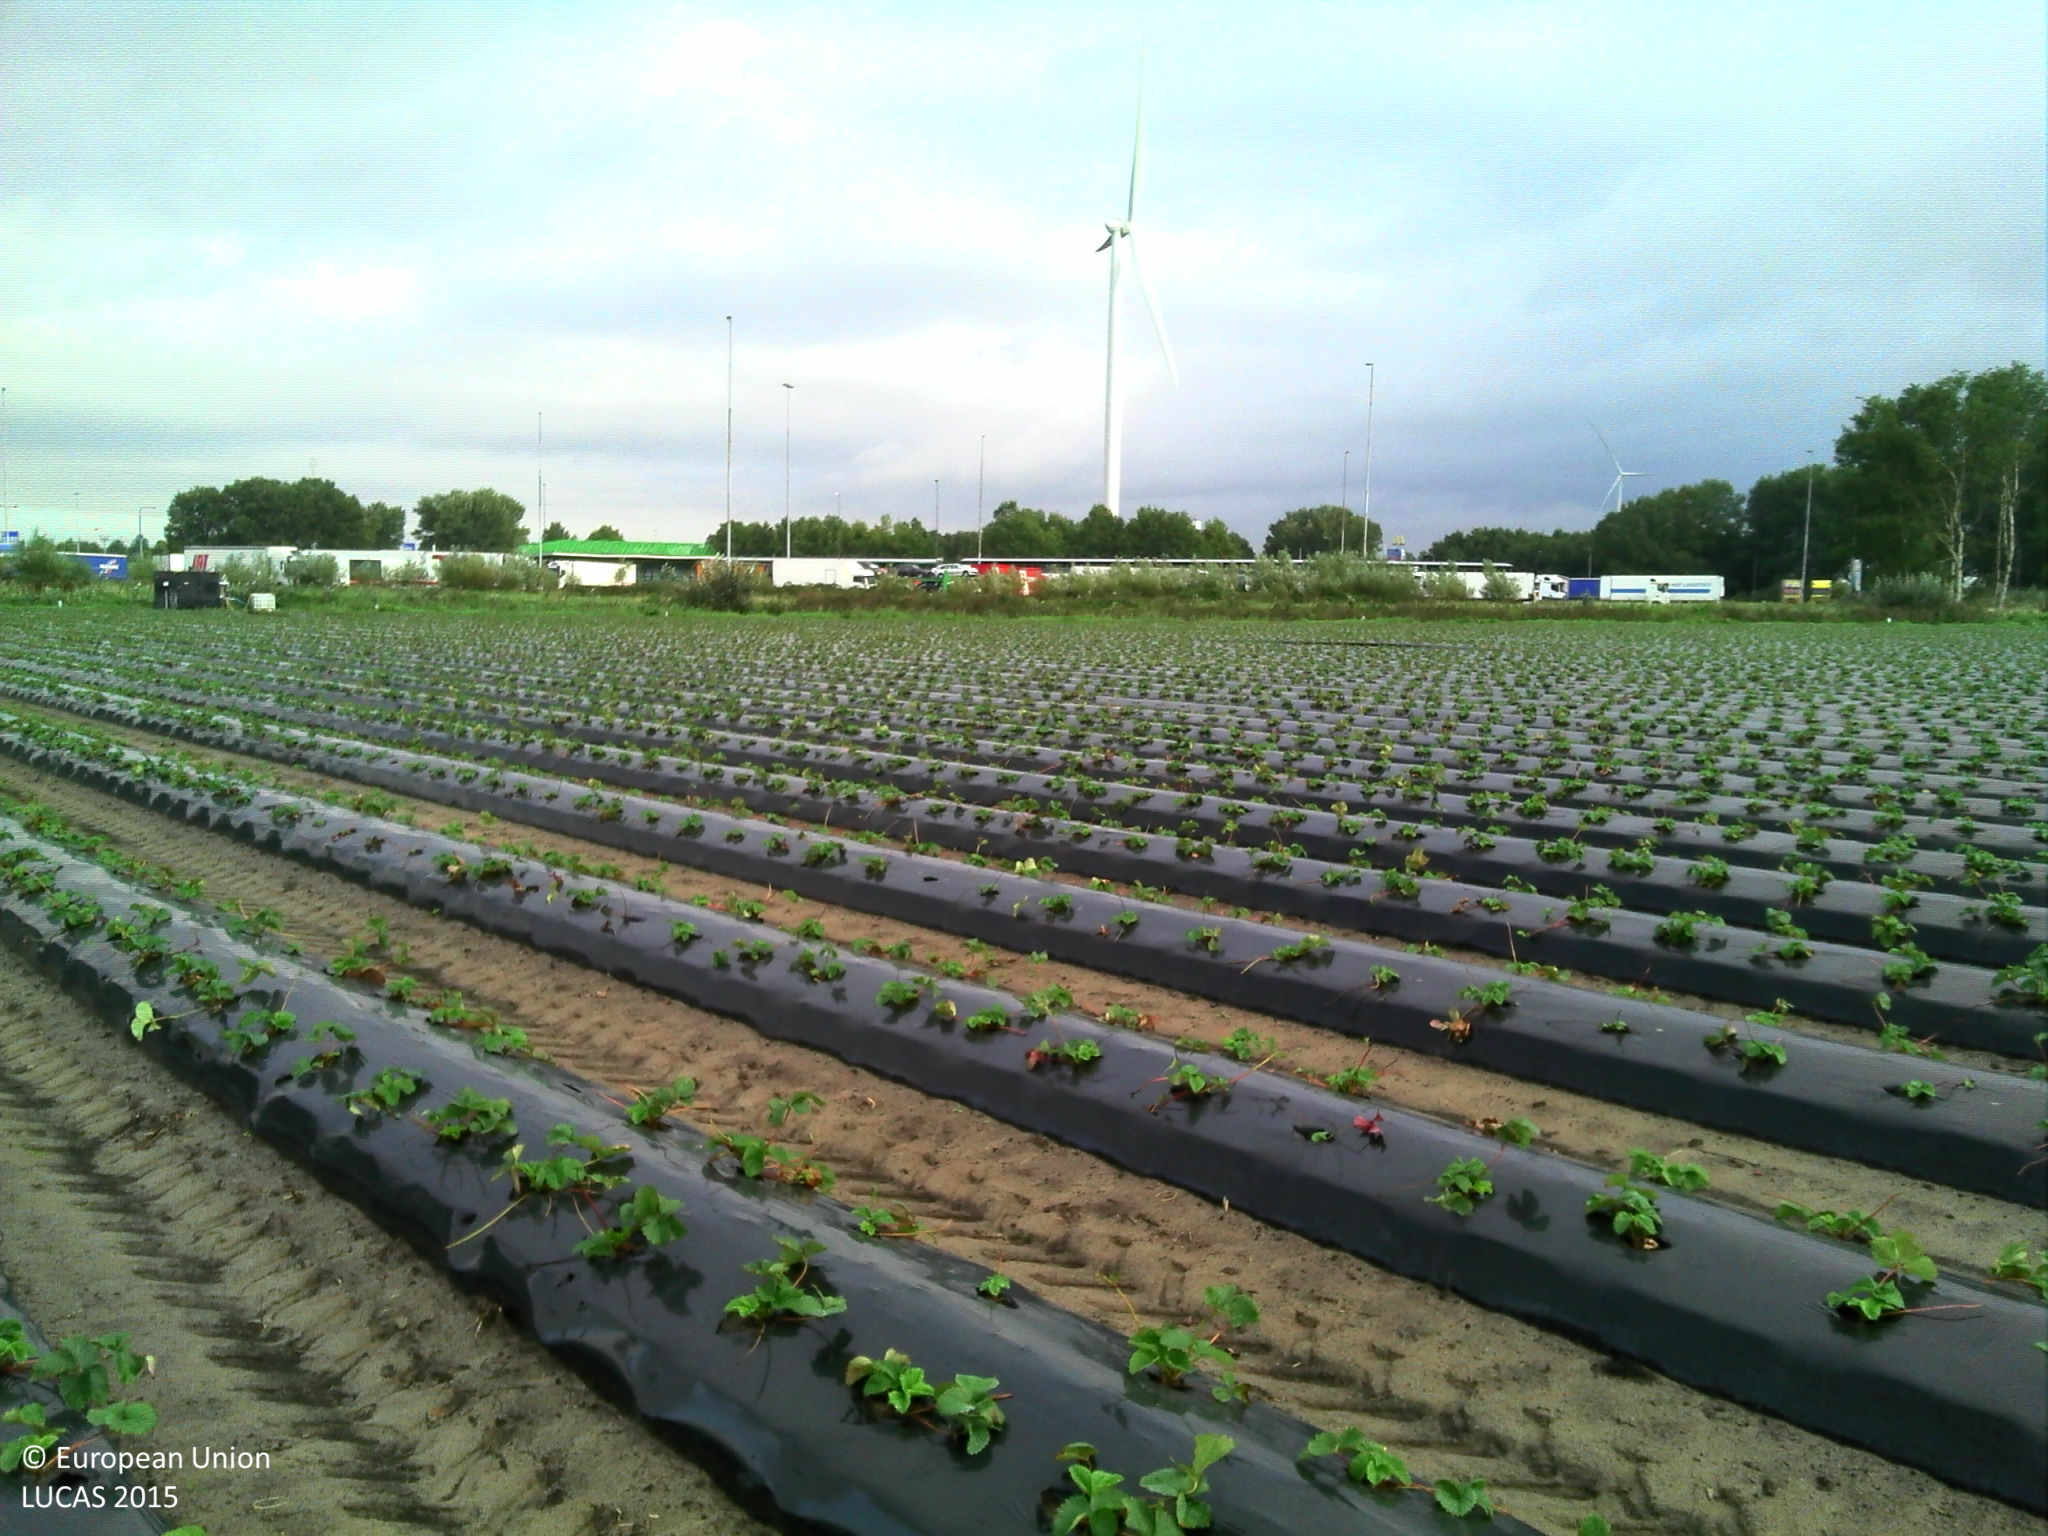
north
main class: Cropland
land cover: Strawberries
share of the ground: < 10 %
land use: Agriculture (excluding fallow land and kitchen gardens)
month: September
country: BE
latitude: 51.4863
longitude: 4.7400
